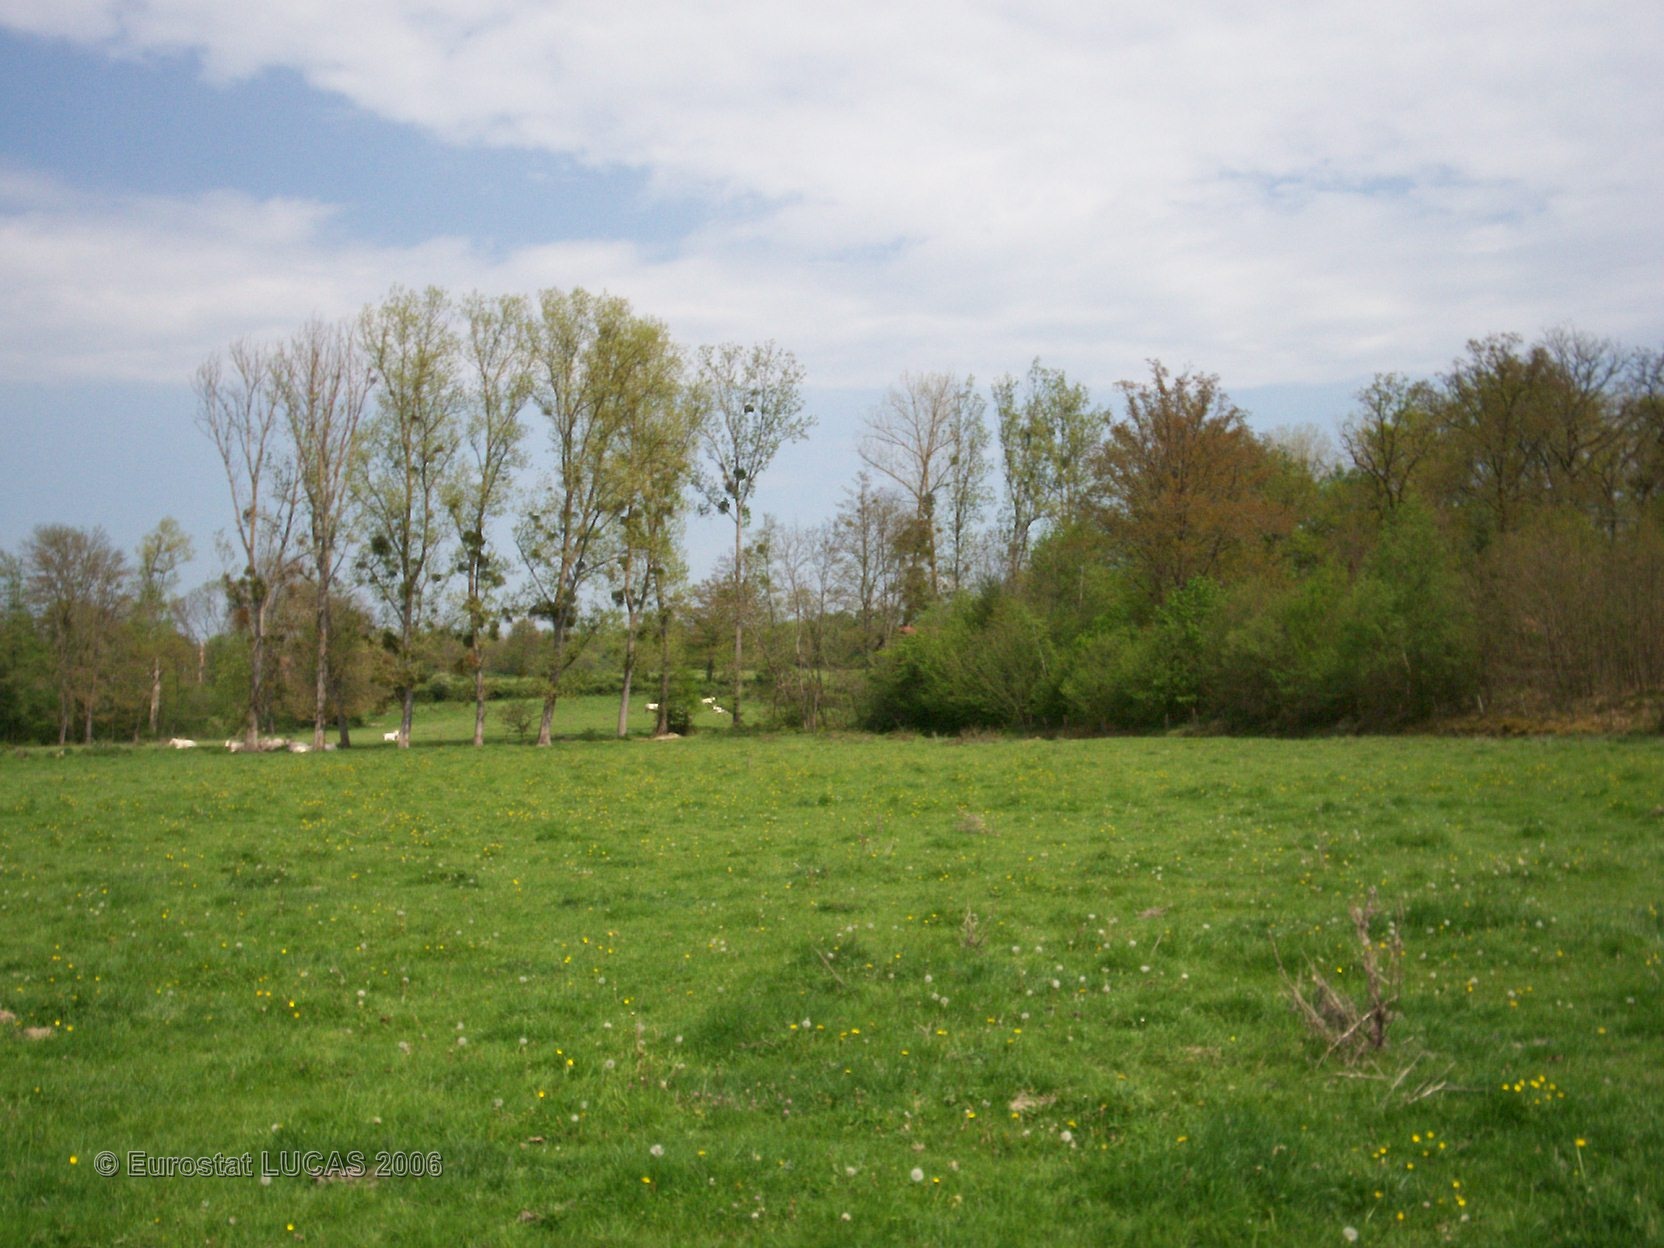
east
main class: Grassland
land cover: Grassland without tree/shrub cover
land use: Agriculture (excluding fallow land and kitchen gardens)
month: May
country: FR
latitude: 45.8282
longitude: 4.1195
